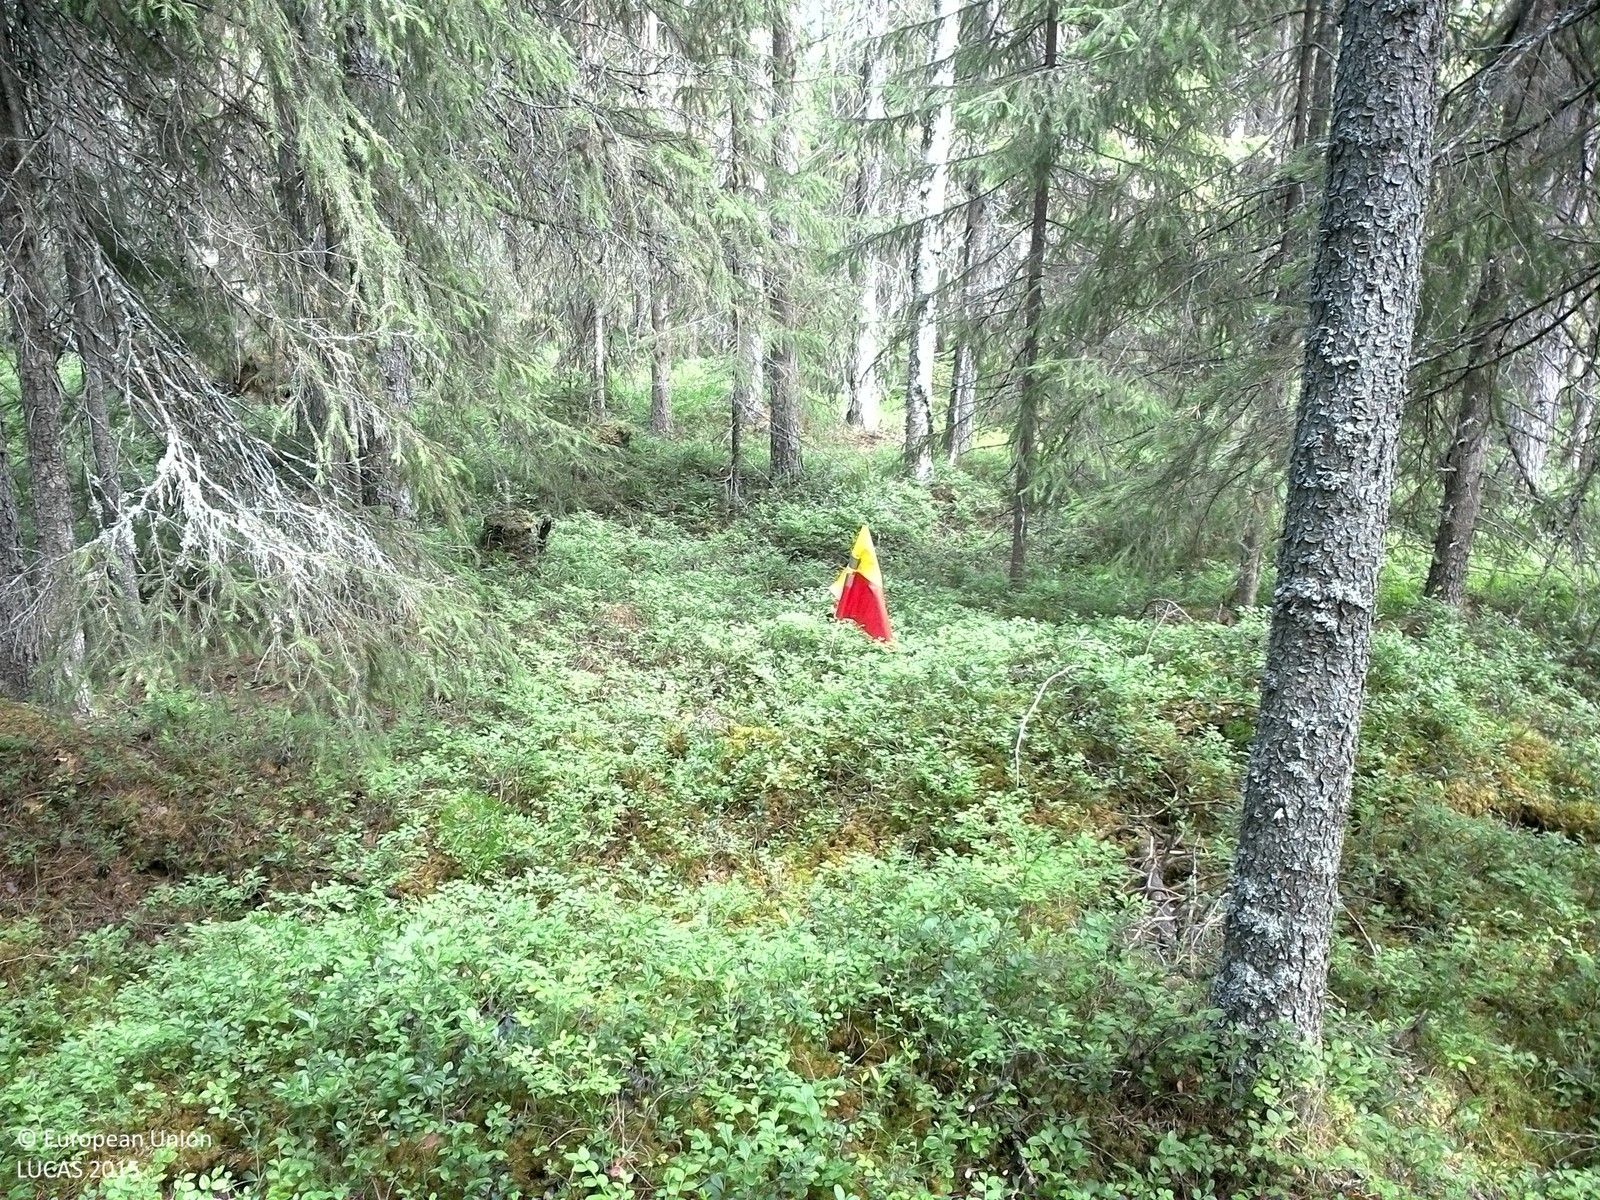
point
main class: Woodland
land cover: Spruce dominated coniferous woodland
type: boreal forest
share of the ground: 50 - 75 %
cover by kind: coniferous forest trees 60 %, shrubs 25 %, lichens and mosses 10 %, broadleaved forest trees 5 %
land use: Forestry
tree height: > 5 m
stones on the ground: < 10 %
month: August
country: SE
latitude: 63.7483
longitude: 16.7201
